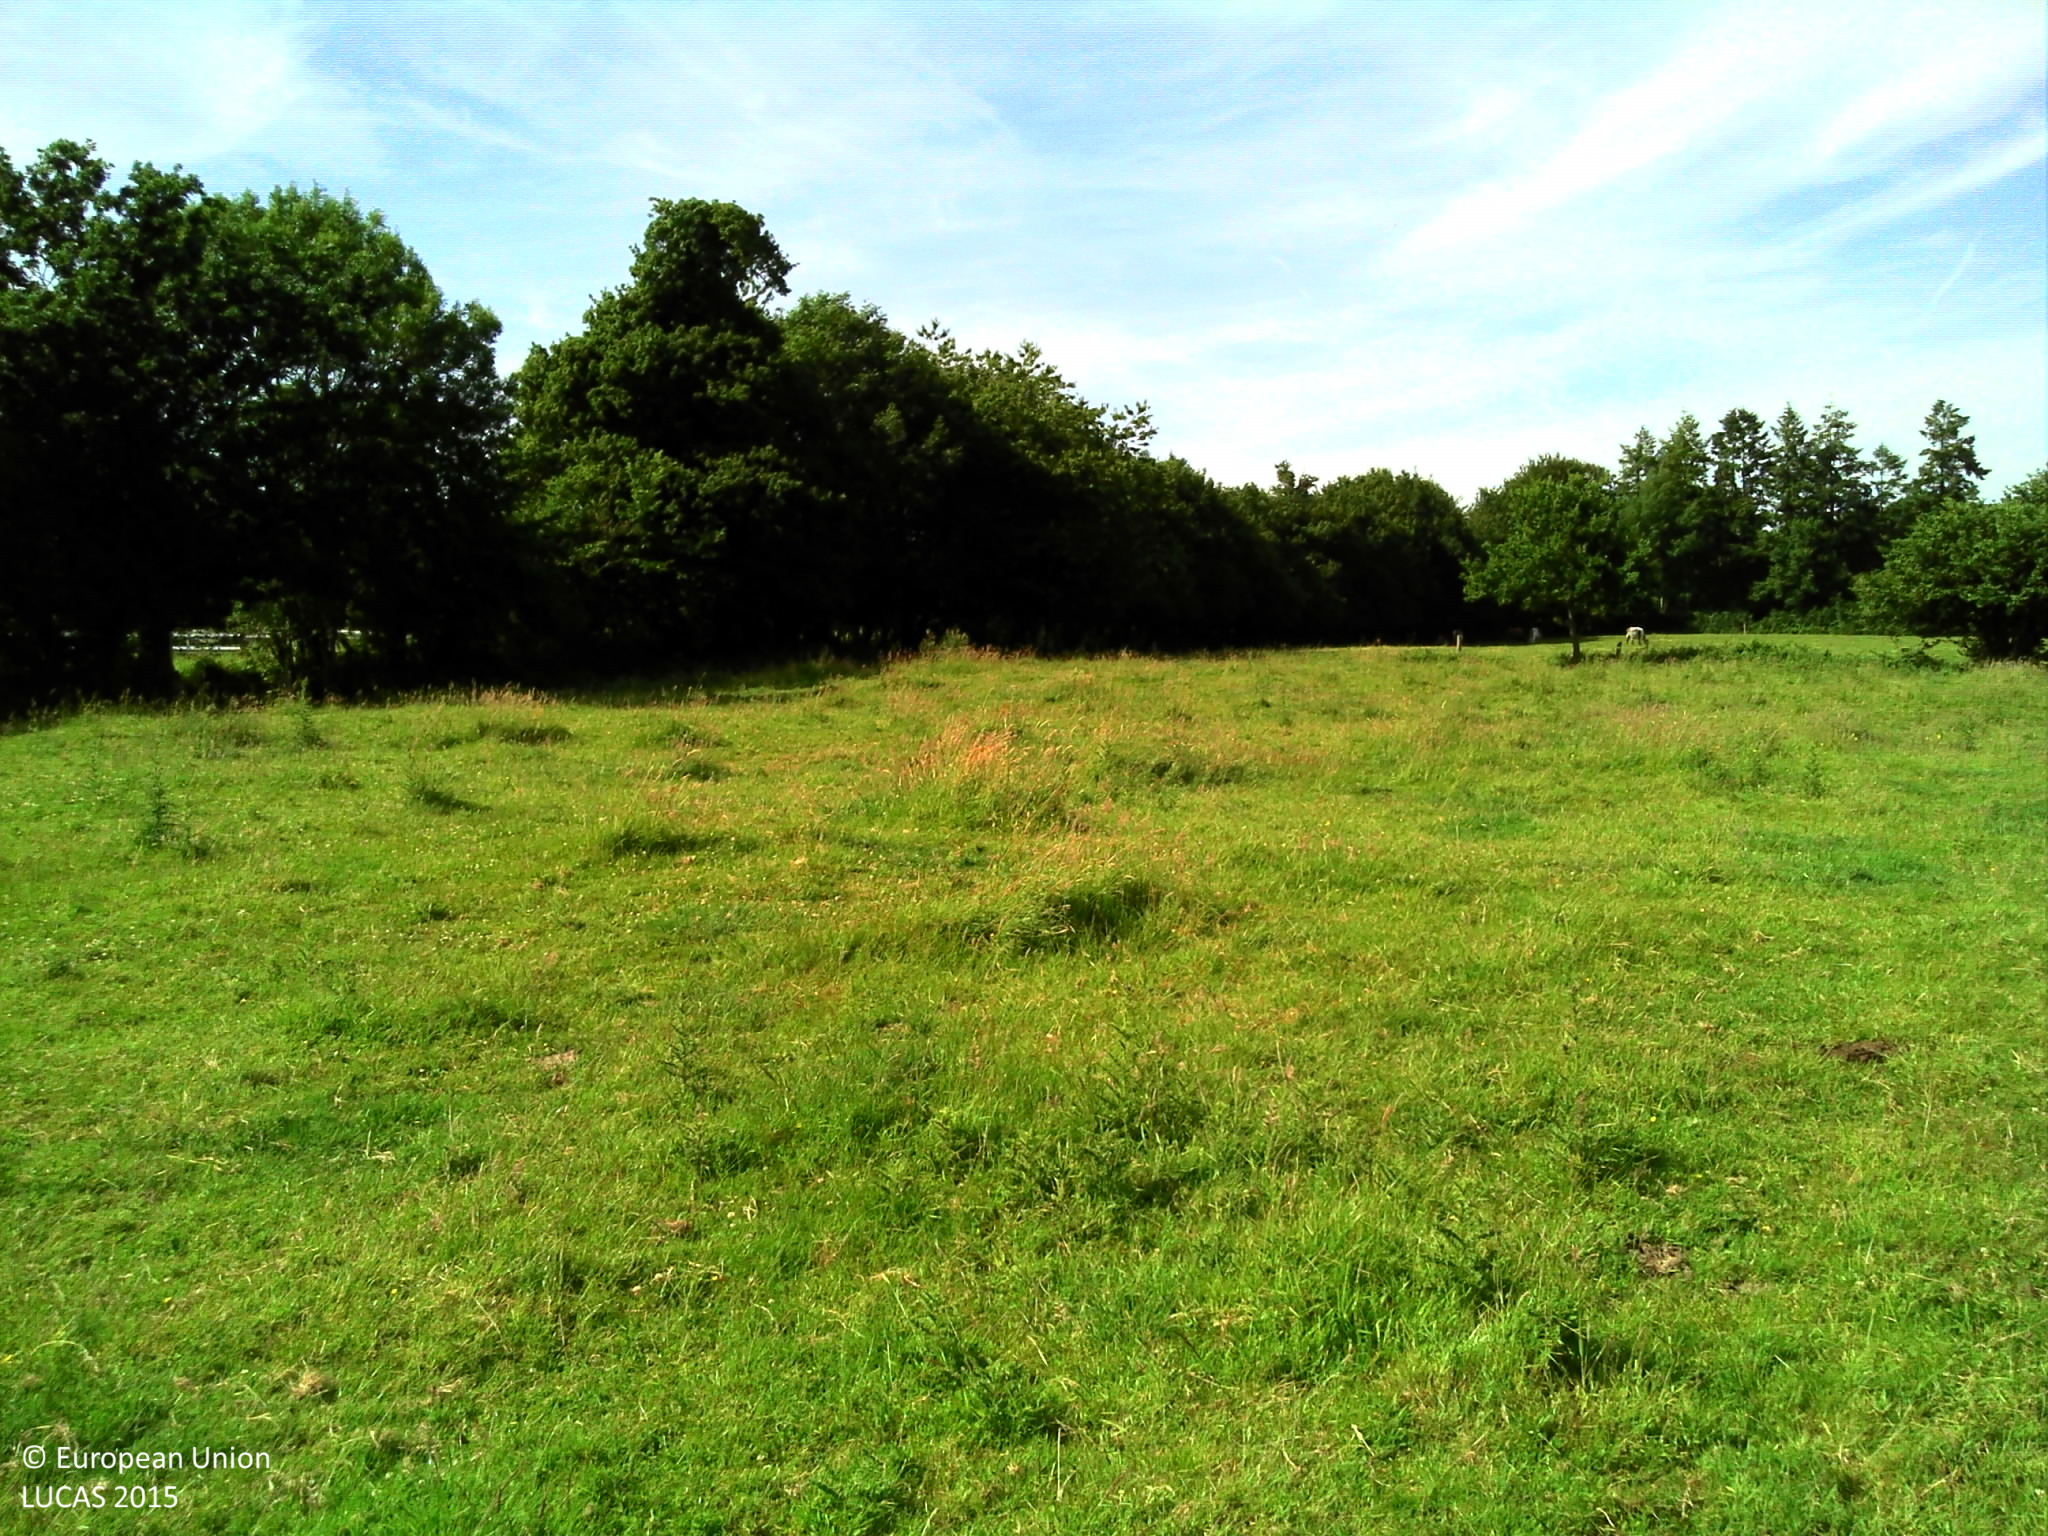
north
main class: Grassland
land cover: Grassland without tree/shrub cover
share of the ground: > 75 %
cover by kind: herbaceous plants 100 %
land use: Agriculture (excluding fallow land and kitchen gardens)
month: June
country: FR
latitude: 49.1752
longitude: -1.3914
